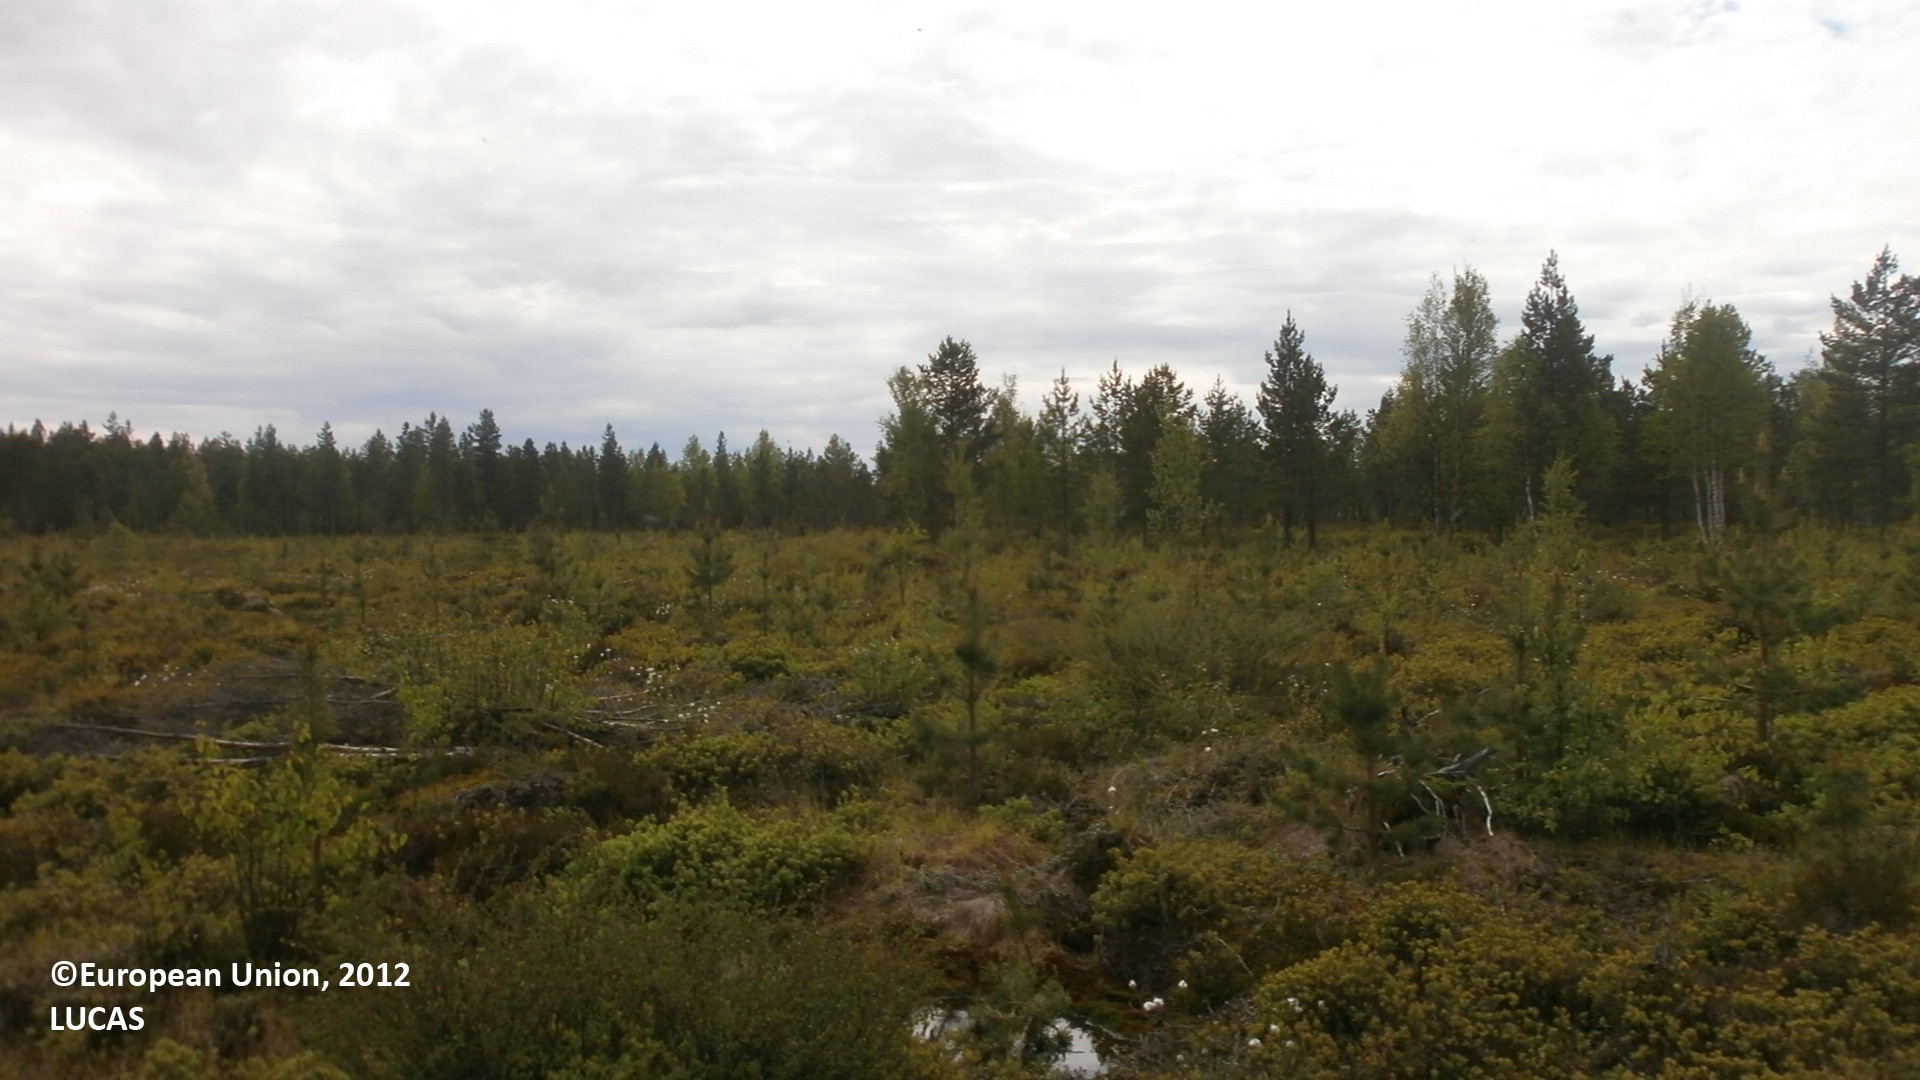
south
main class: Woodland
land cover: Other mixed woodland
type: hemiboreal forest and nemoral coniferous forest and mixed broadleaved-coniferous forest
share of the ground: 10 - 25 %
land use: Forestry
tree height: < 5 m
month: June
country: FI
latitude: 64.4701
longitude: 25.0323
